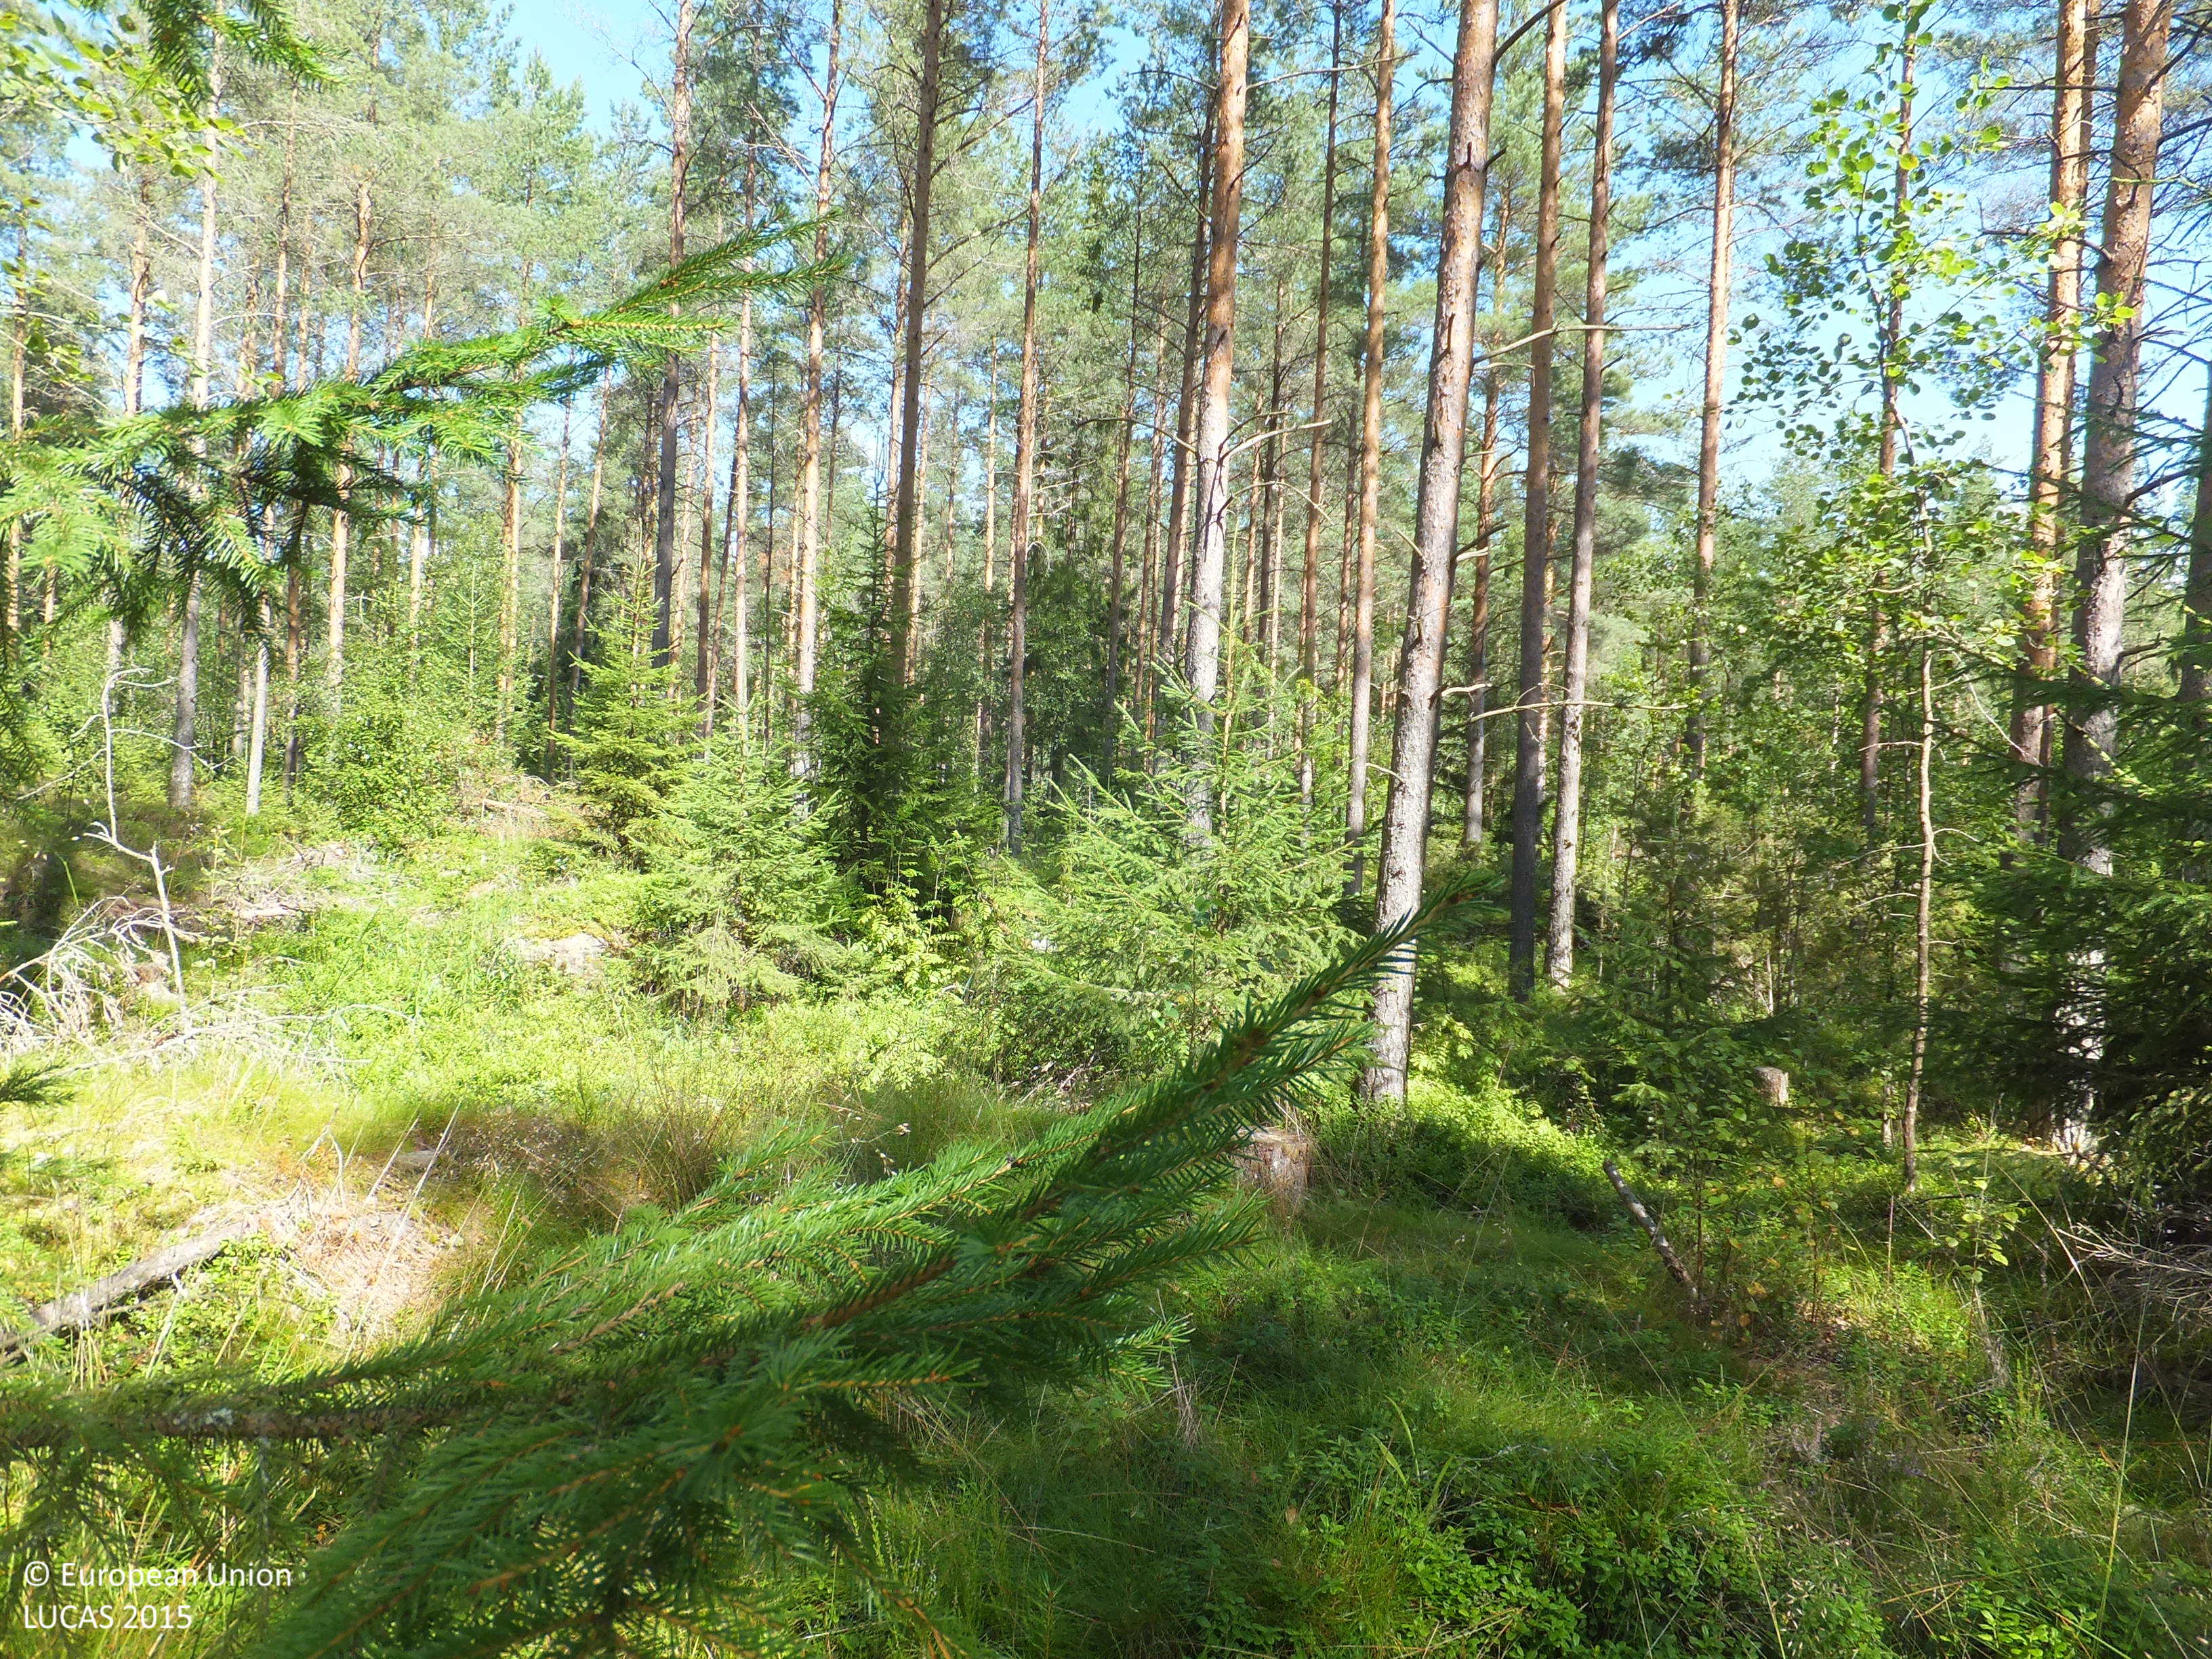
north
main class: Woodland
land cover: Pine dominated mixed woodland
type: boreal forest
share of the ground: 50 - 75 %
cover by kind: coniferous forest trees 40 %, shrubs 20 %, broadleaved forest trees 15 %, herbaceous plants 10 %, lichens and mosses 10 %, consolidated bare surface 5 %
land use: Forestry
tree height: > 5 m
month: August
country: FI
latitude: 63.0788
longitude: 22.7040
